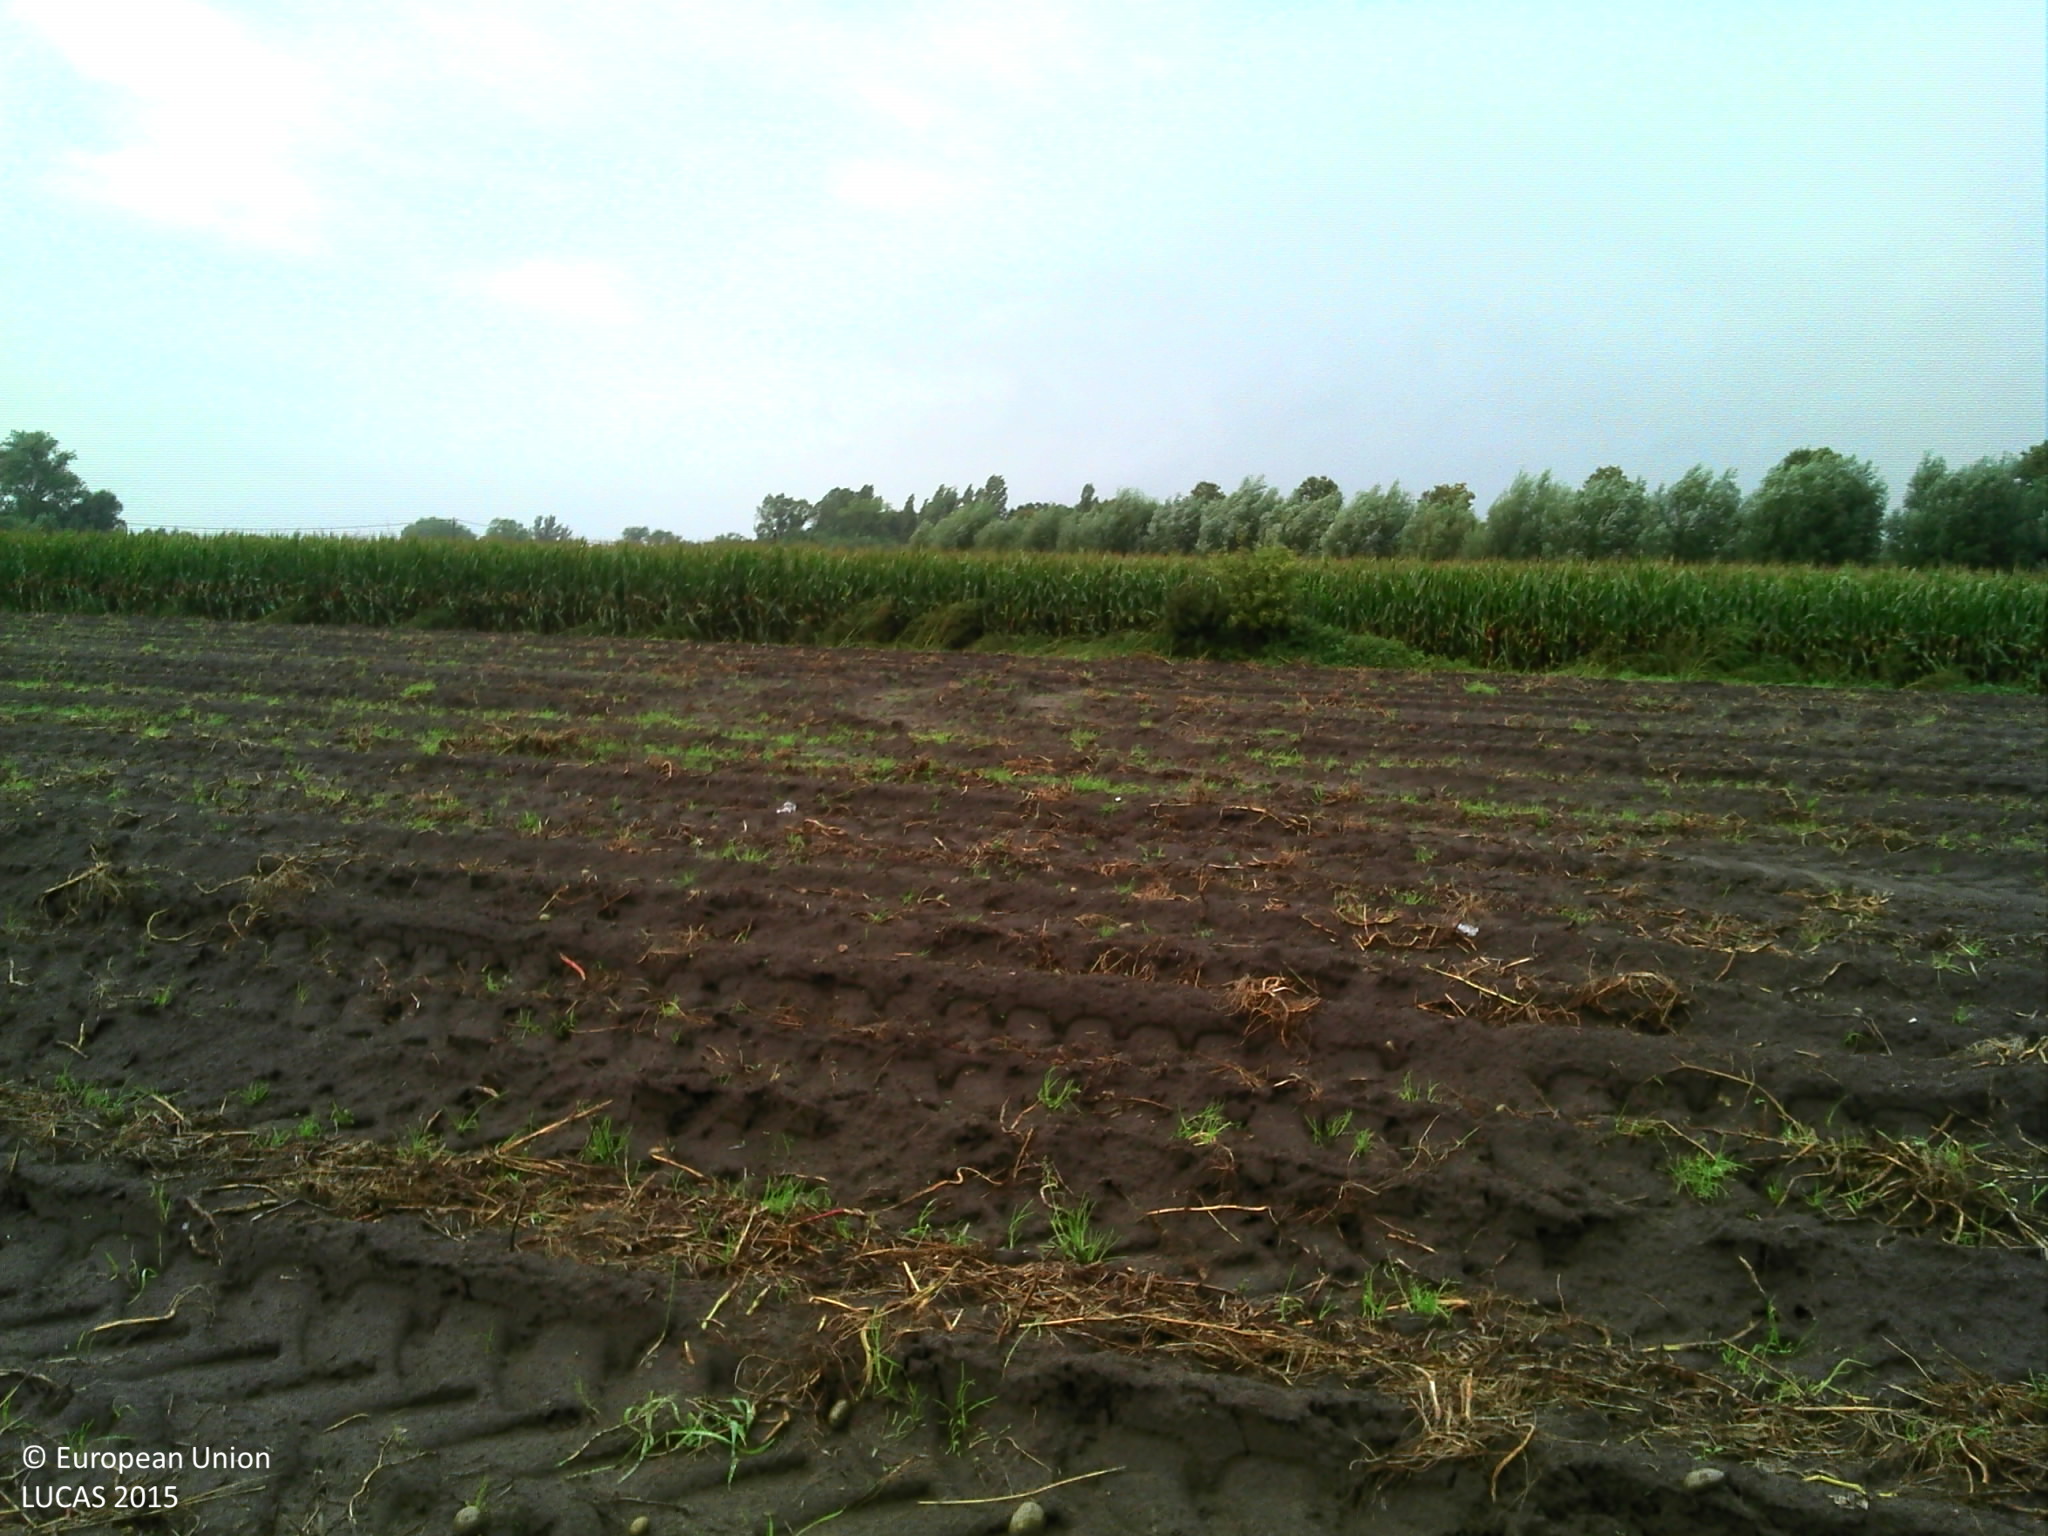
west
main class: Grassland
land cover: Spontaneously vegetated surfaces
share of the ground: > 75 %
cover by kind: herbaceous plants 100 %
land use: Fallow land
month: September
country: BE
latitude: 51.1797
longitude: 3.0234
